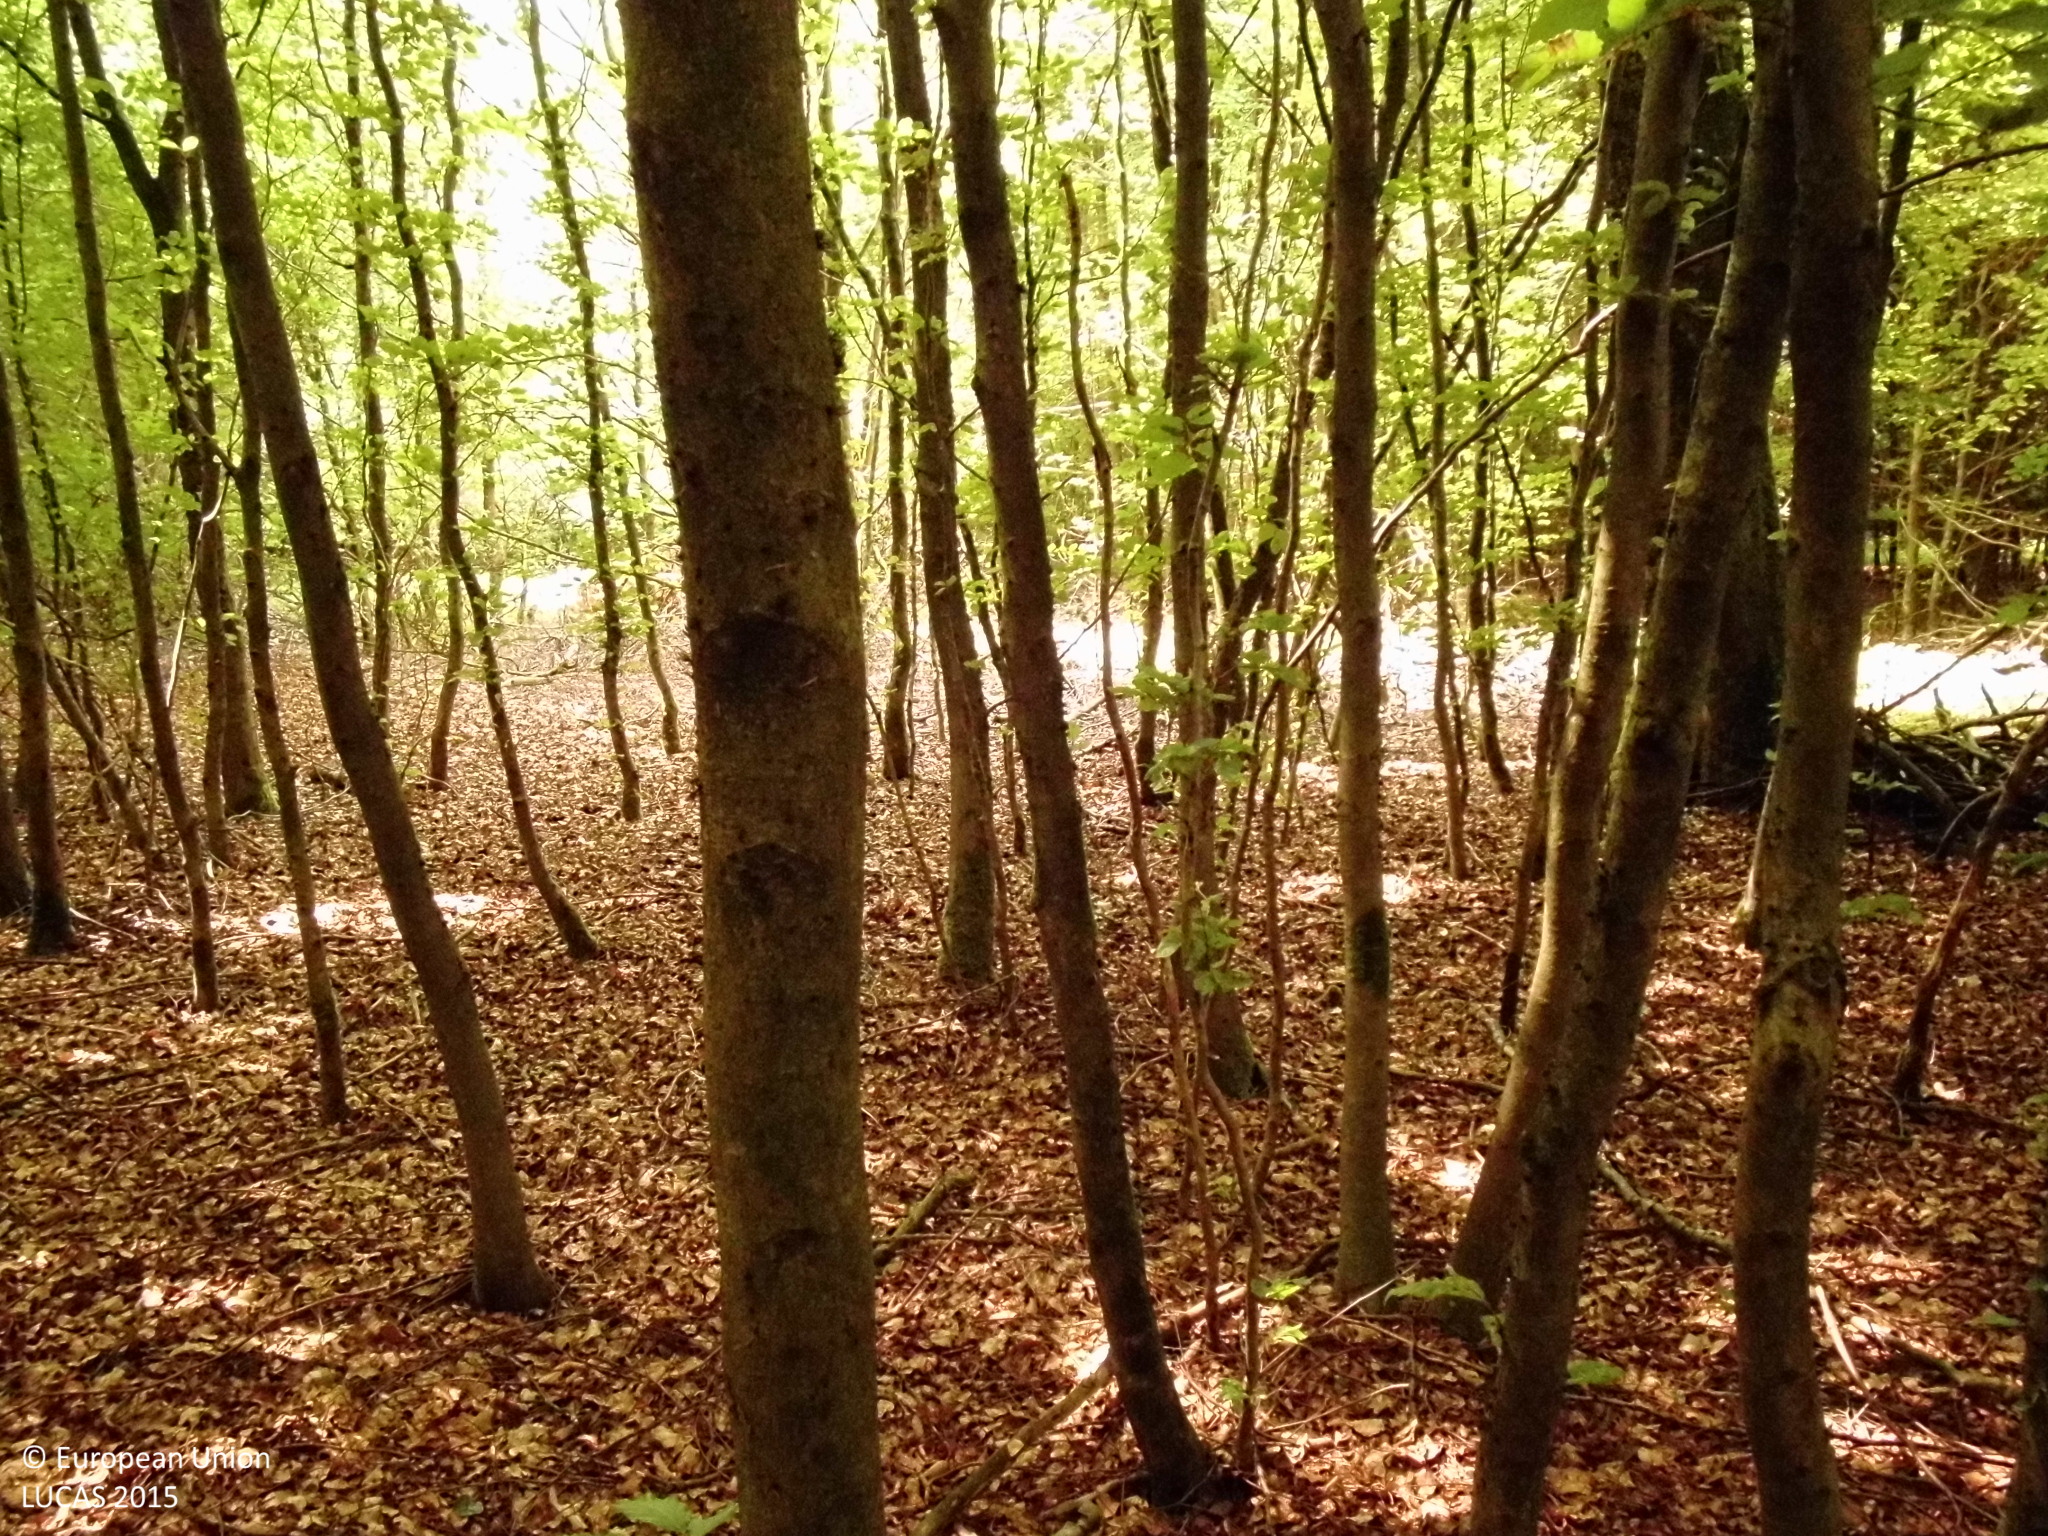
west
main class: Woodland
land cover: Spruce dominated mixed woodland
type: hemiboreal forest and nemoral coniferous forest and mixed broadleaved-coniferous forest
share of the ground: > 75 %
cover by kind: coniferous forest trees 70 %, broadleaved forest trees 30 %
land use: Forestry
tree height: > 5 m
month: May
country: DE
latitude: 50.5539
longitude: 7.5585
